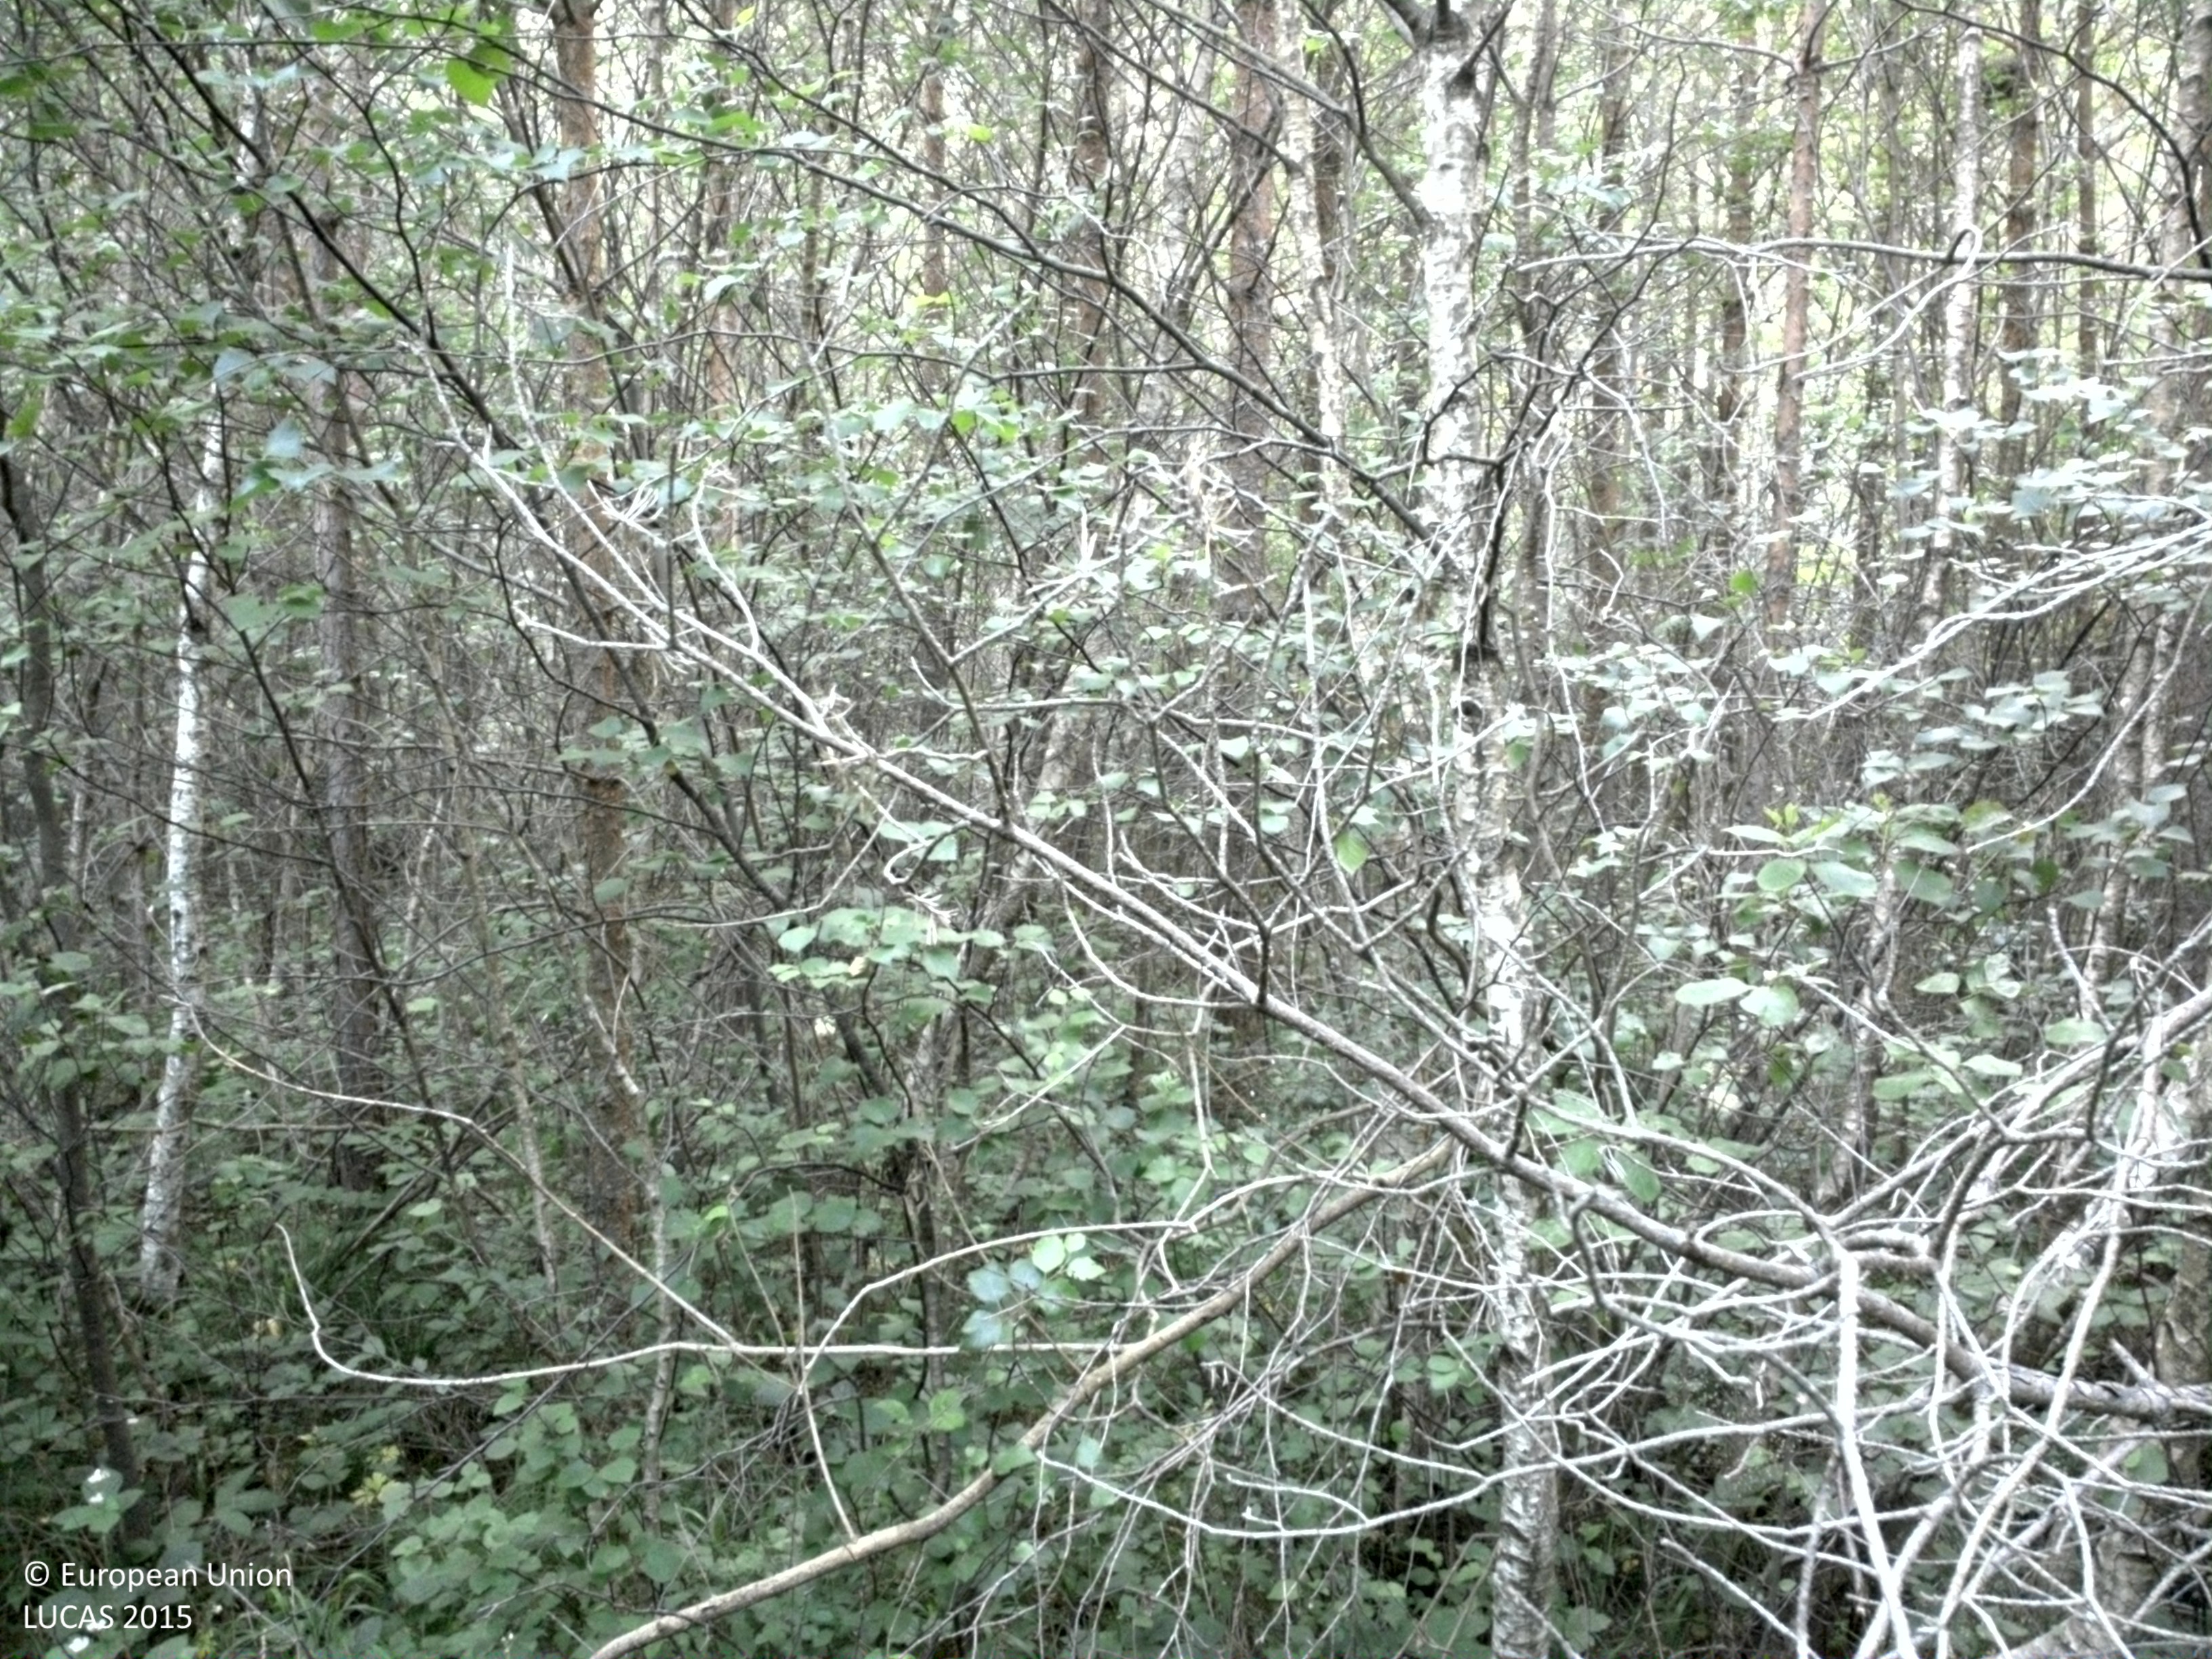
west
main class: Woodland
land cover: Pine dominated mixed woodland
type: hemiboreal forest and nemoral coniferous forest and mixed broadleaved-coniferous forest
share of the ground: > 75 %
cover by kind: coniferous forest trees 65 %, broadleaved forest trees 25 %, shrubs 5 %, herbaceous plants 5 %
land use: Forestry
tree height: > 5 m
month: July
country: SE
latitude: 57.5993
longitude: 18.3233
